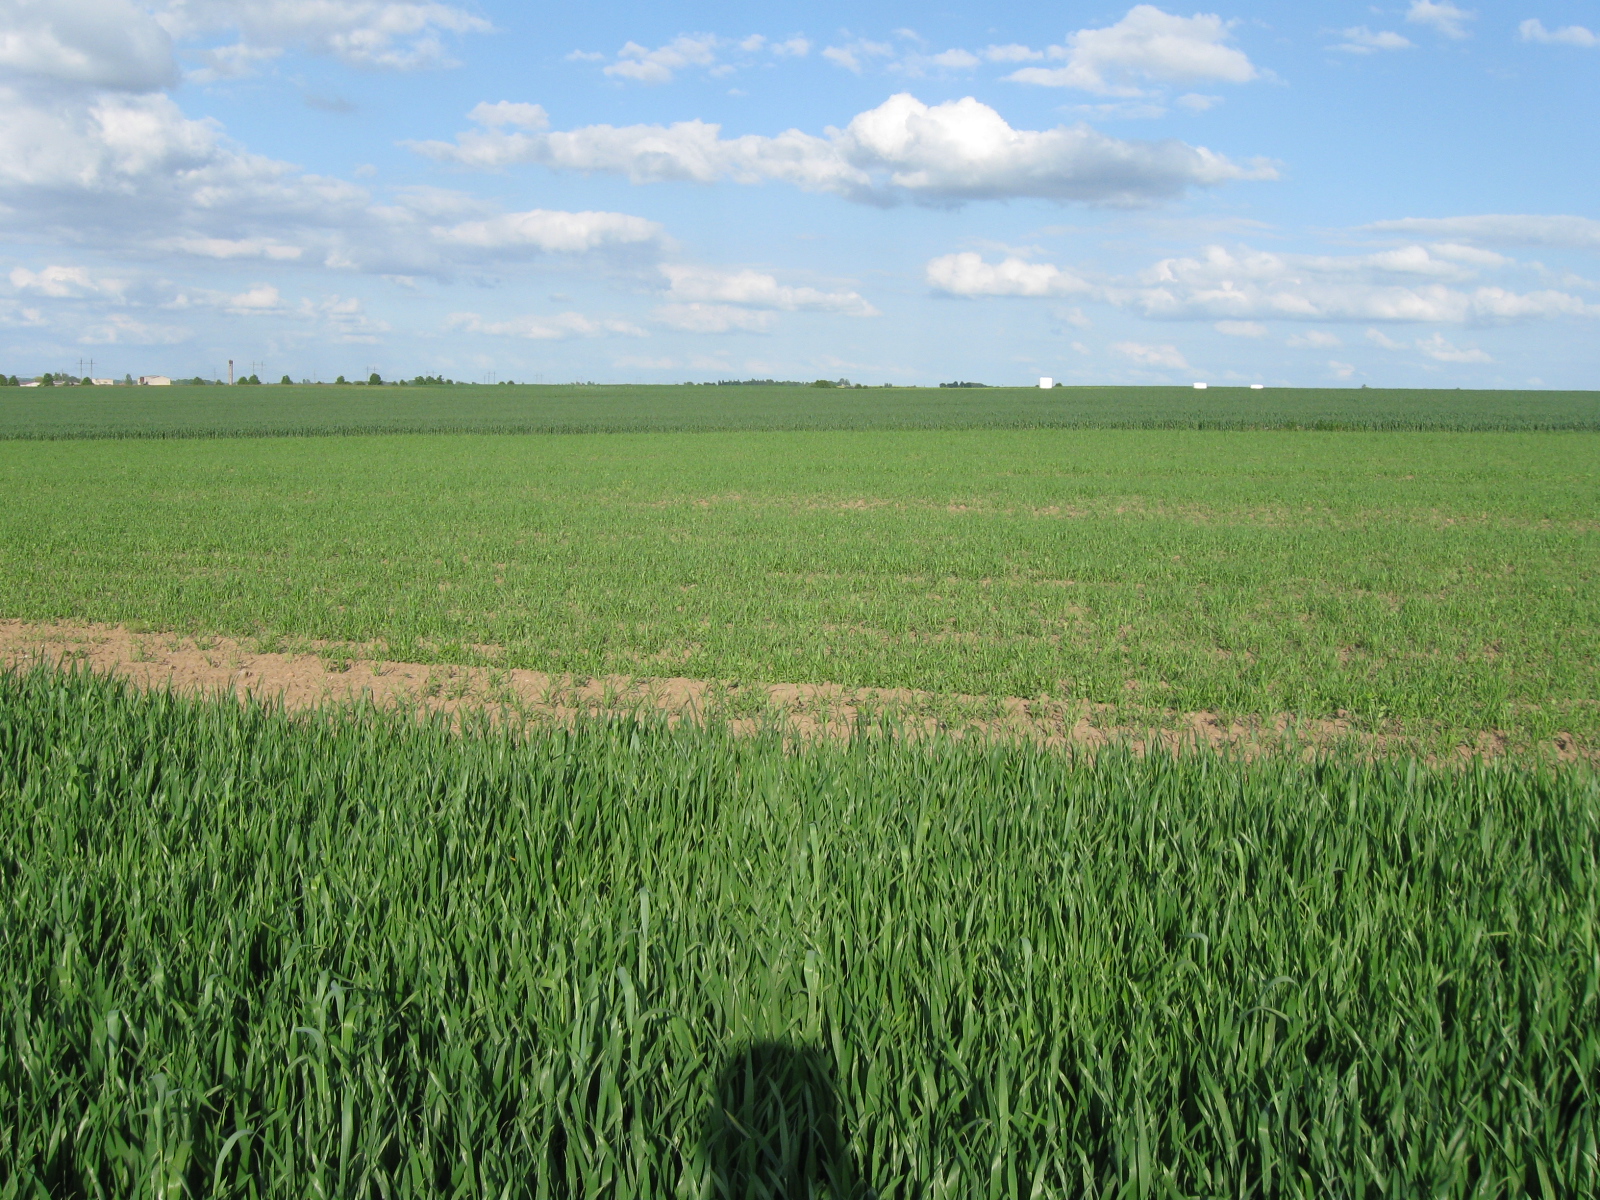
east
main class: Cropland
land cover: Common wheat
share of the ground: > 75 %
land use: Agriculture (excluding fallow land and kitchen gardens)
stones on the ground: < 10 %
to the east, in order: Common wheat; Other leguminous and mixtures for fodder; Common wheat; Barley; Common wheat
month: May
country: LT
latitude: 54.6125
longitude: 22.8122
